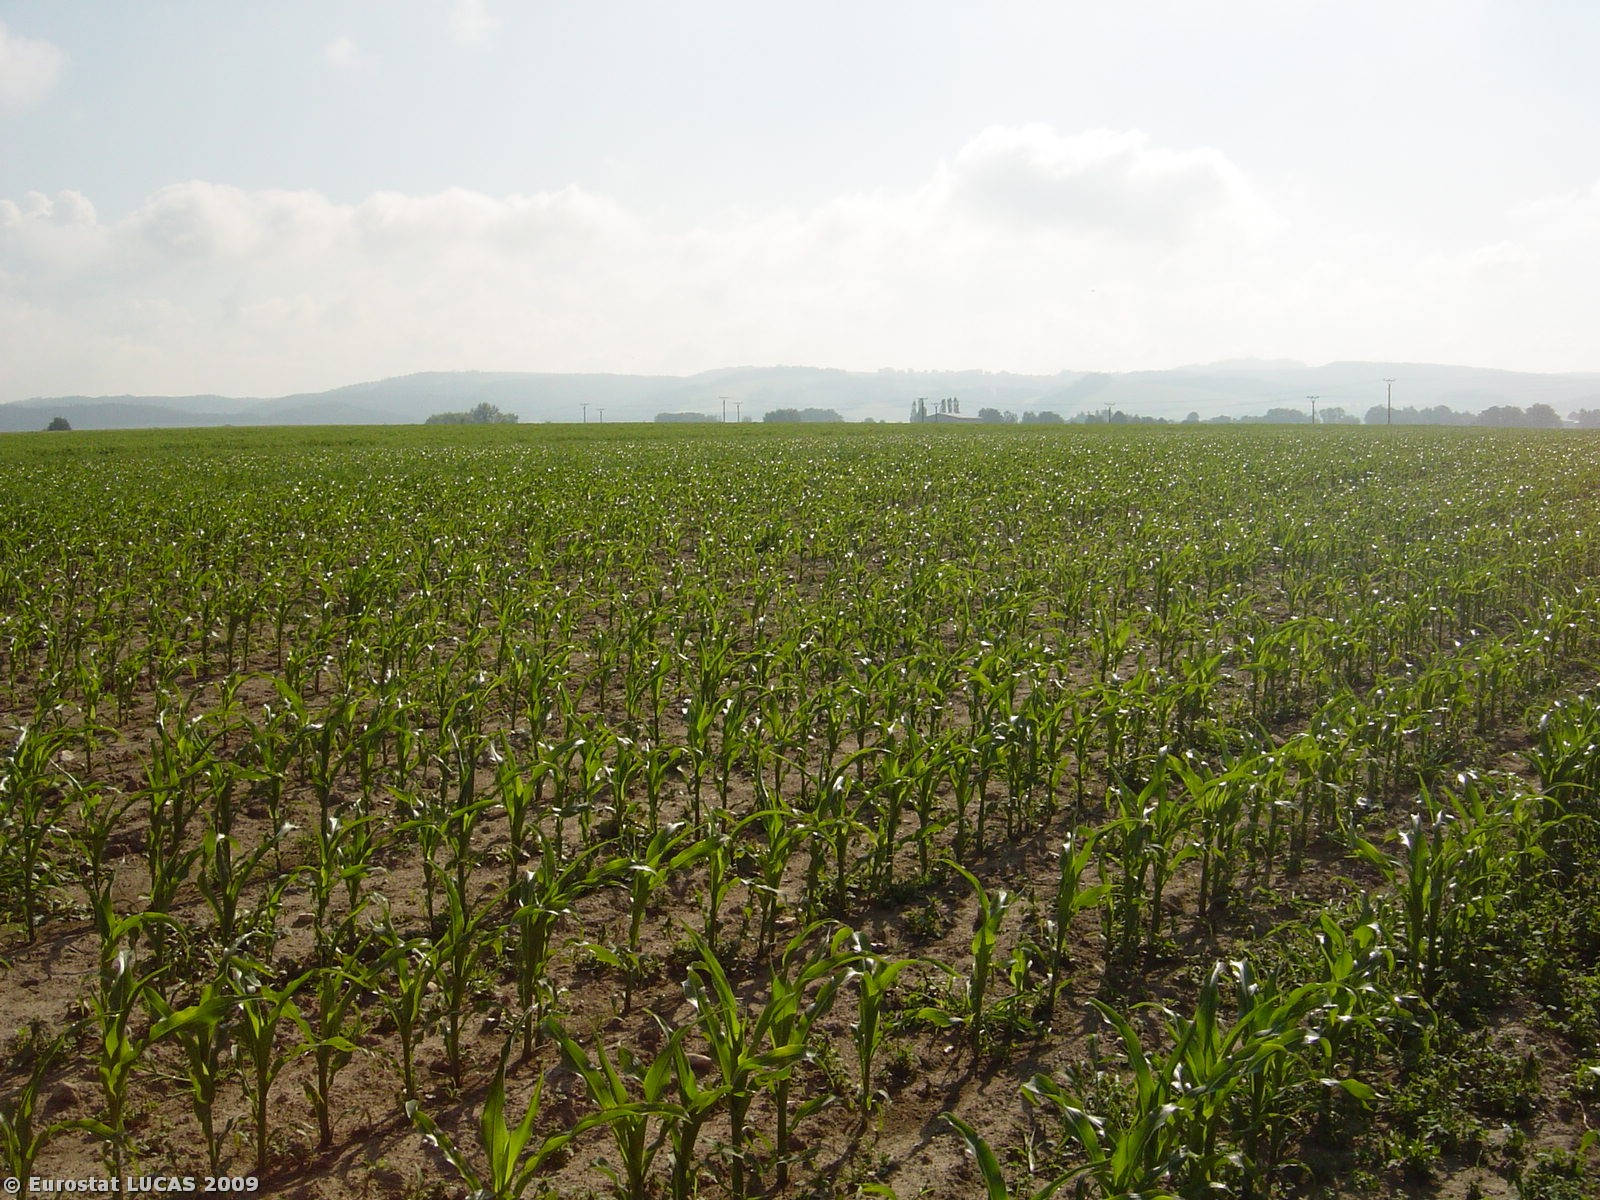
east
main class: Cropland
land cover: Maize
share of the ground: 50 - 75 %
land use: Agriculture (excluding fallow land and kitchen gardens)
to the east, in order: Maize; Dry pulses
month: June
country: CZ
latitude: 49.9210
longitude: 16.5959
